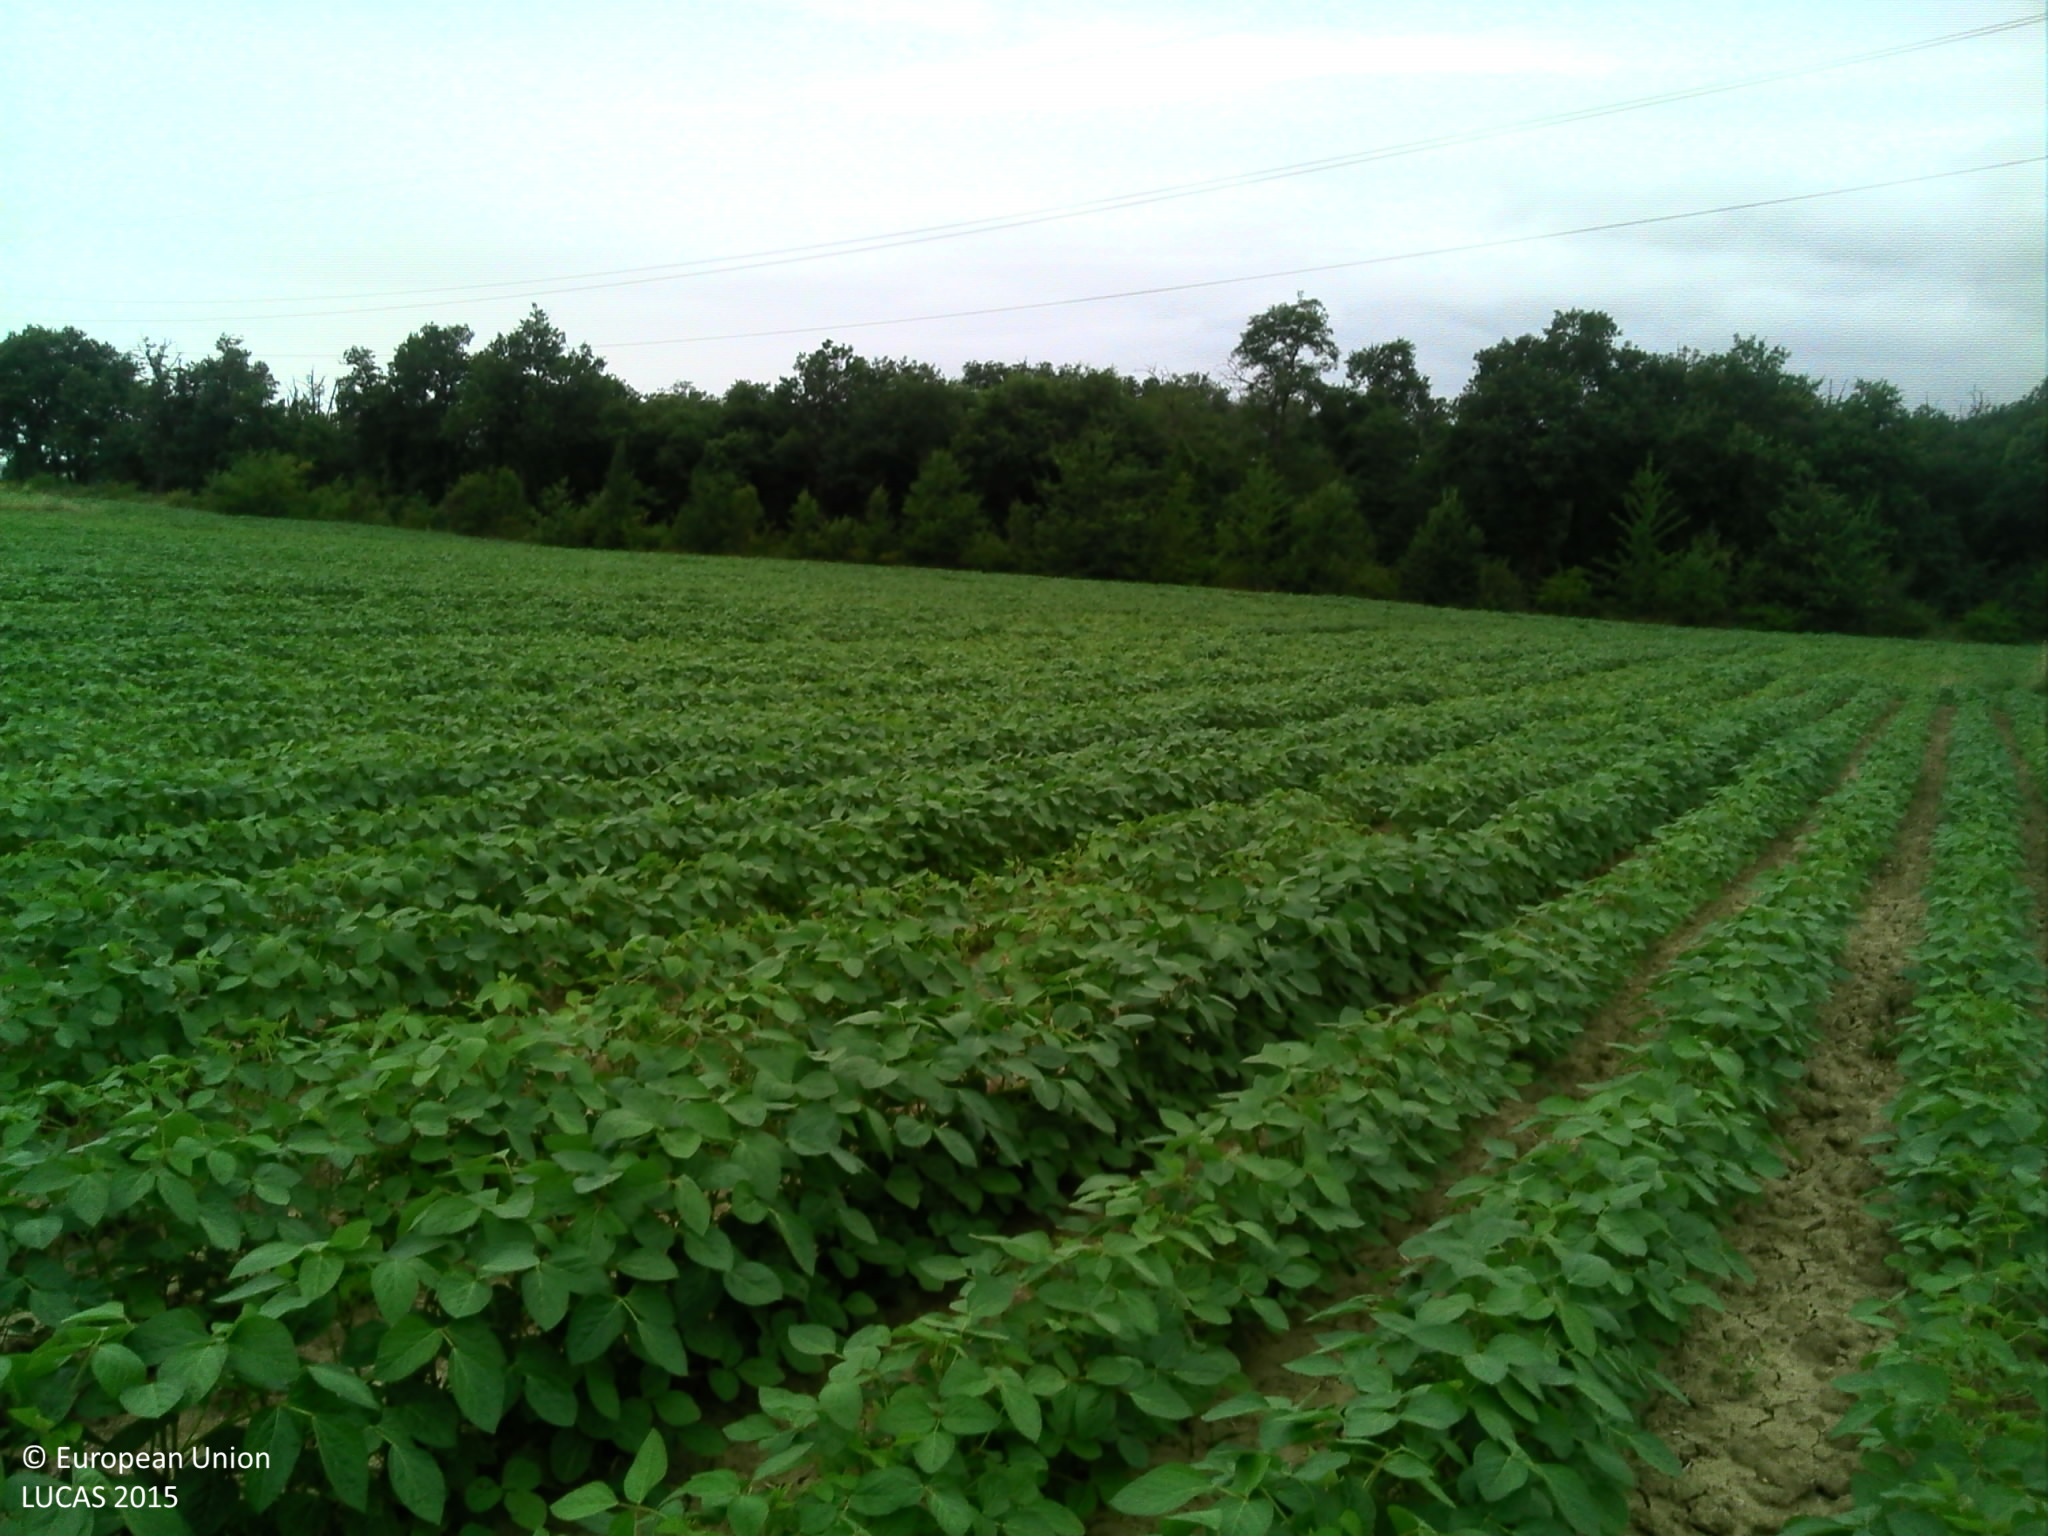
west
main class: Cropland
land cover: Soya
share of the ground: > 75 %
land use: Agriculture (excluding fallow land and kitchen gardens)
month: July
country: FR
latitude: 43.4845
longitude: 1.6086
